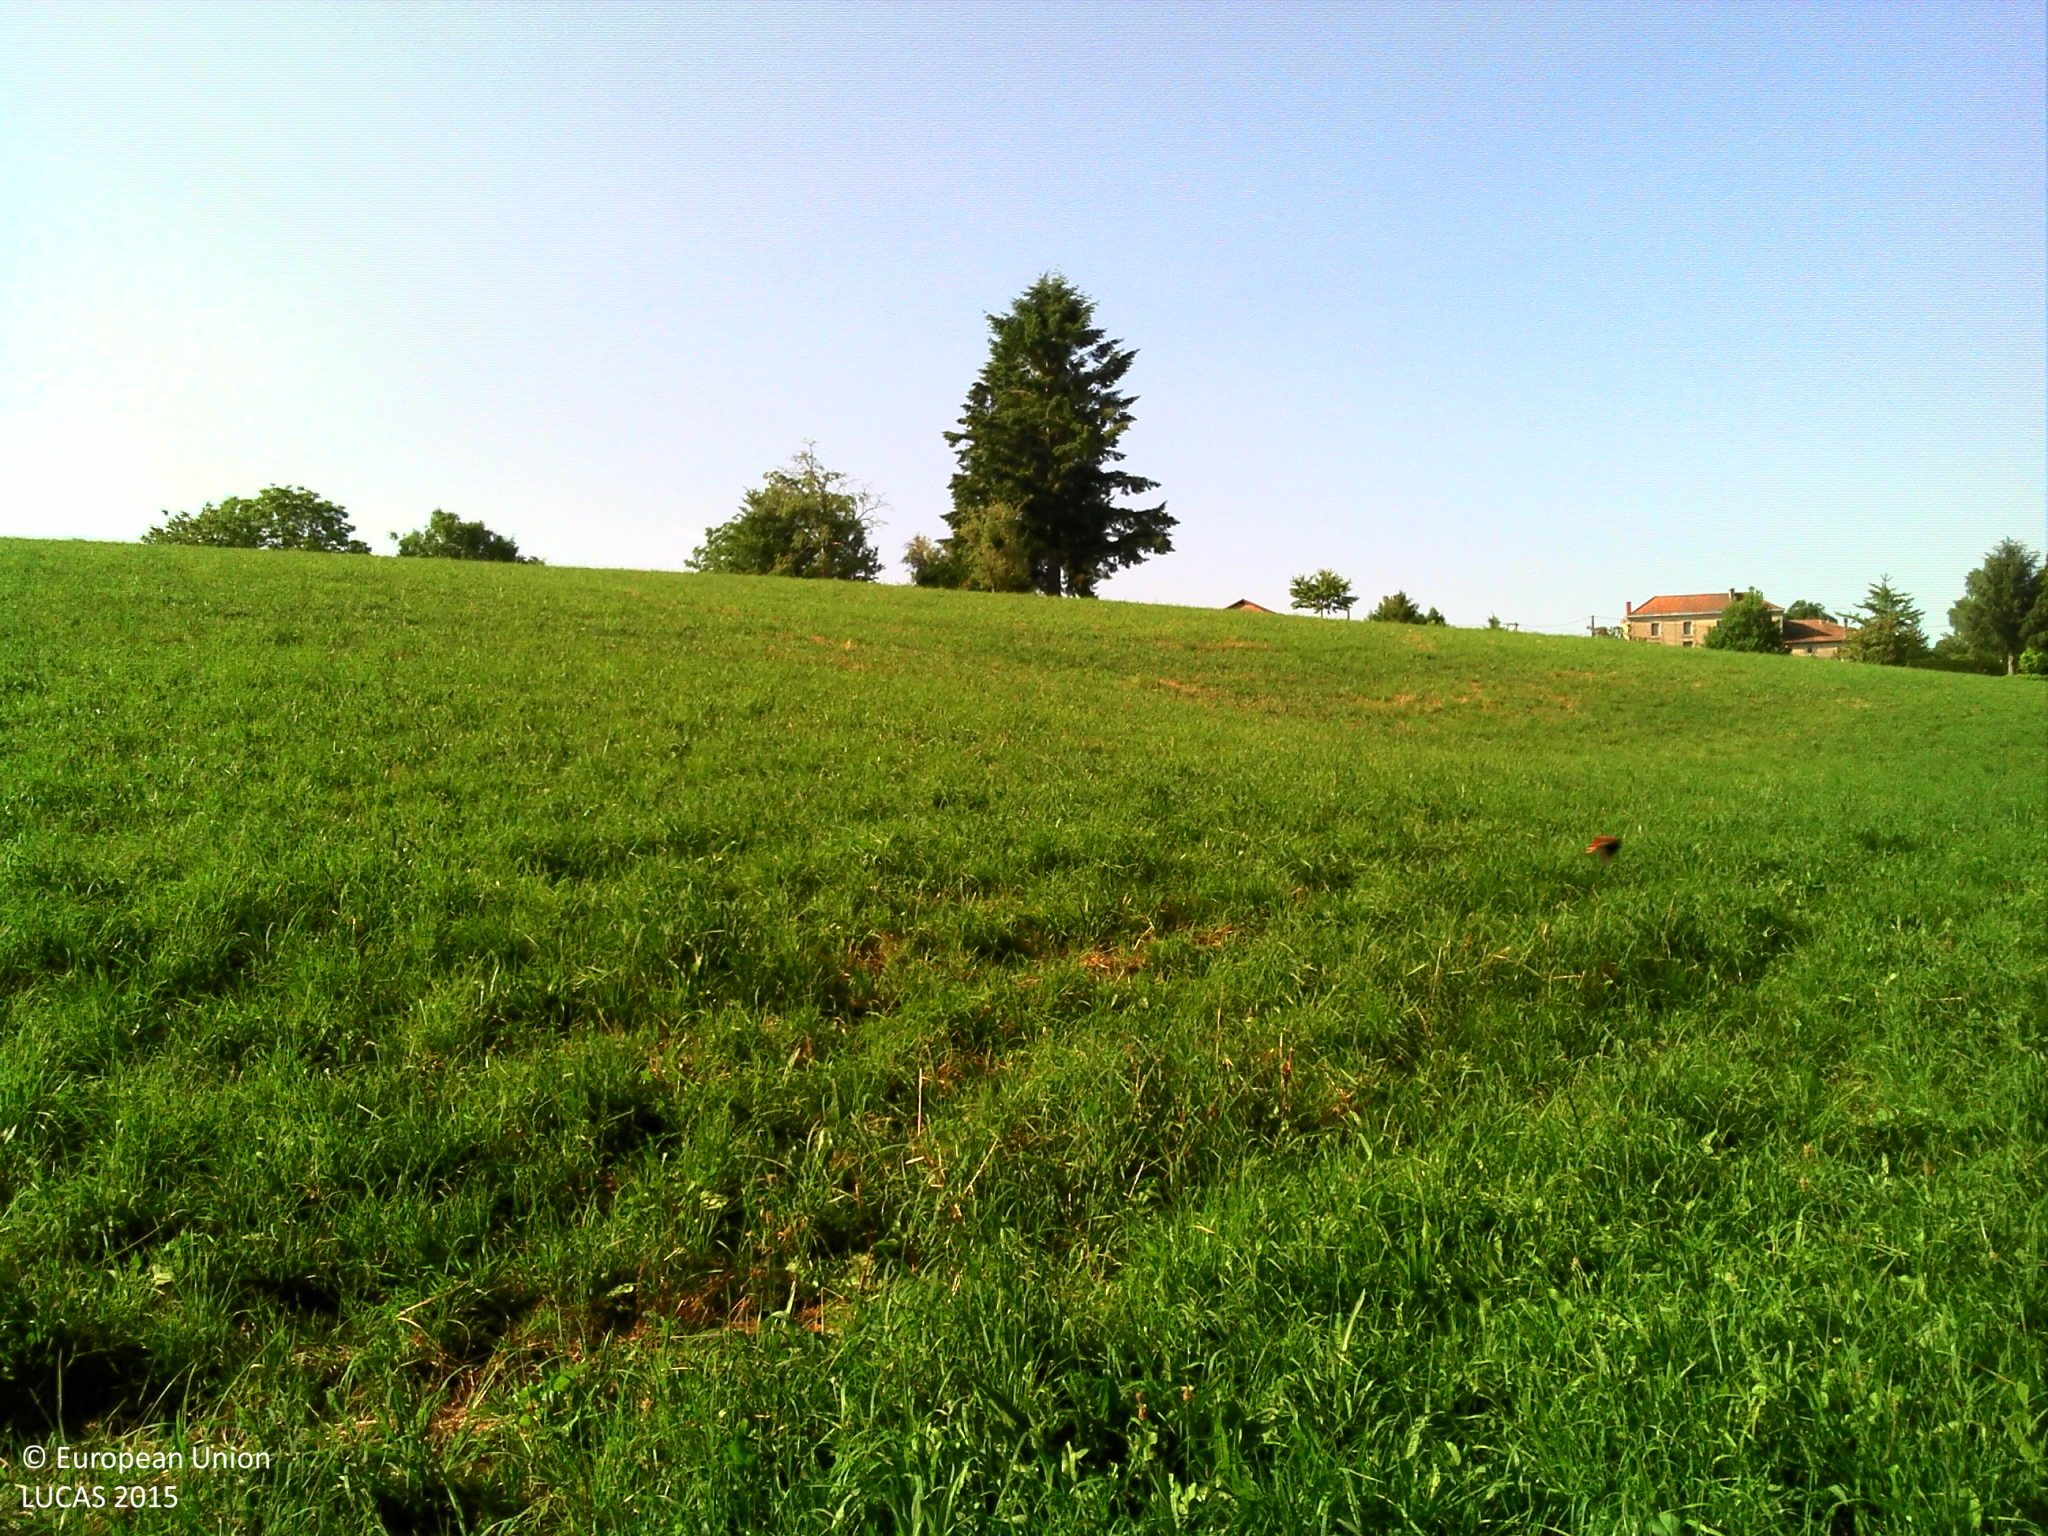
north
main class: Grassland
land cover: Grassland without tree/shrub cover
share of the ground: > 75 %
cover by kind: herbaceous plants 100 %
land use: Agriculture (excluding fallow land and kitchen gardens)
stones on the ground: < 10 %
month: June
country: FR
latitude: 45.7207
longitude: 0.6207
